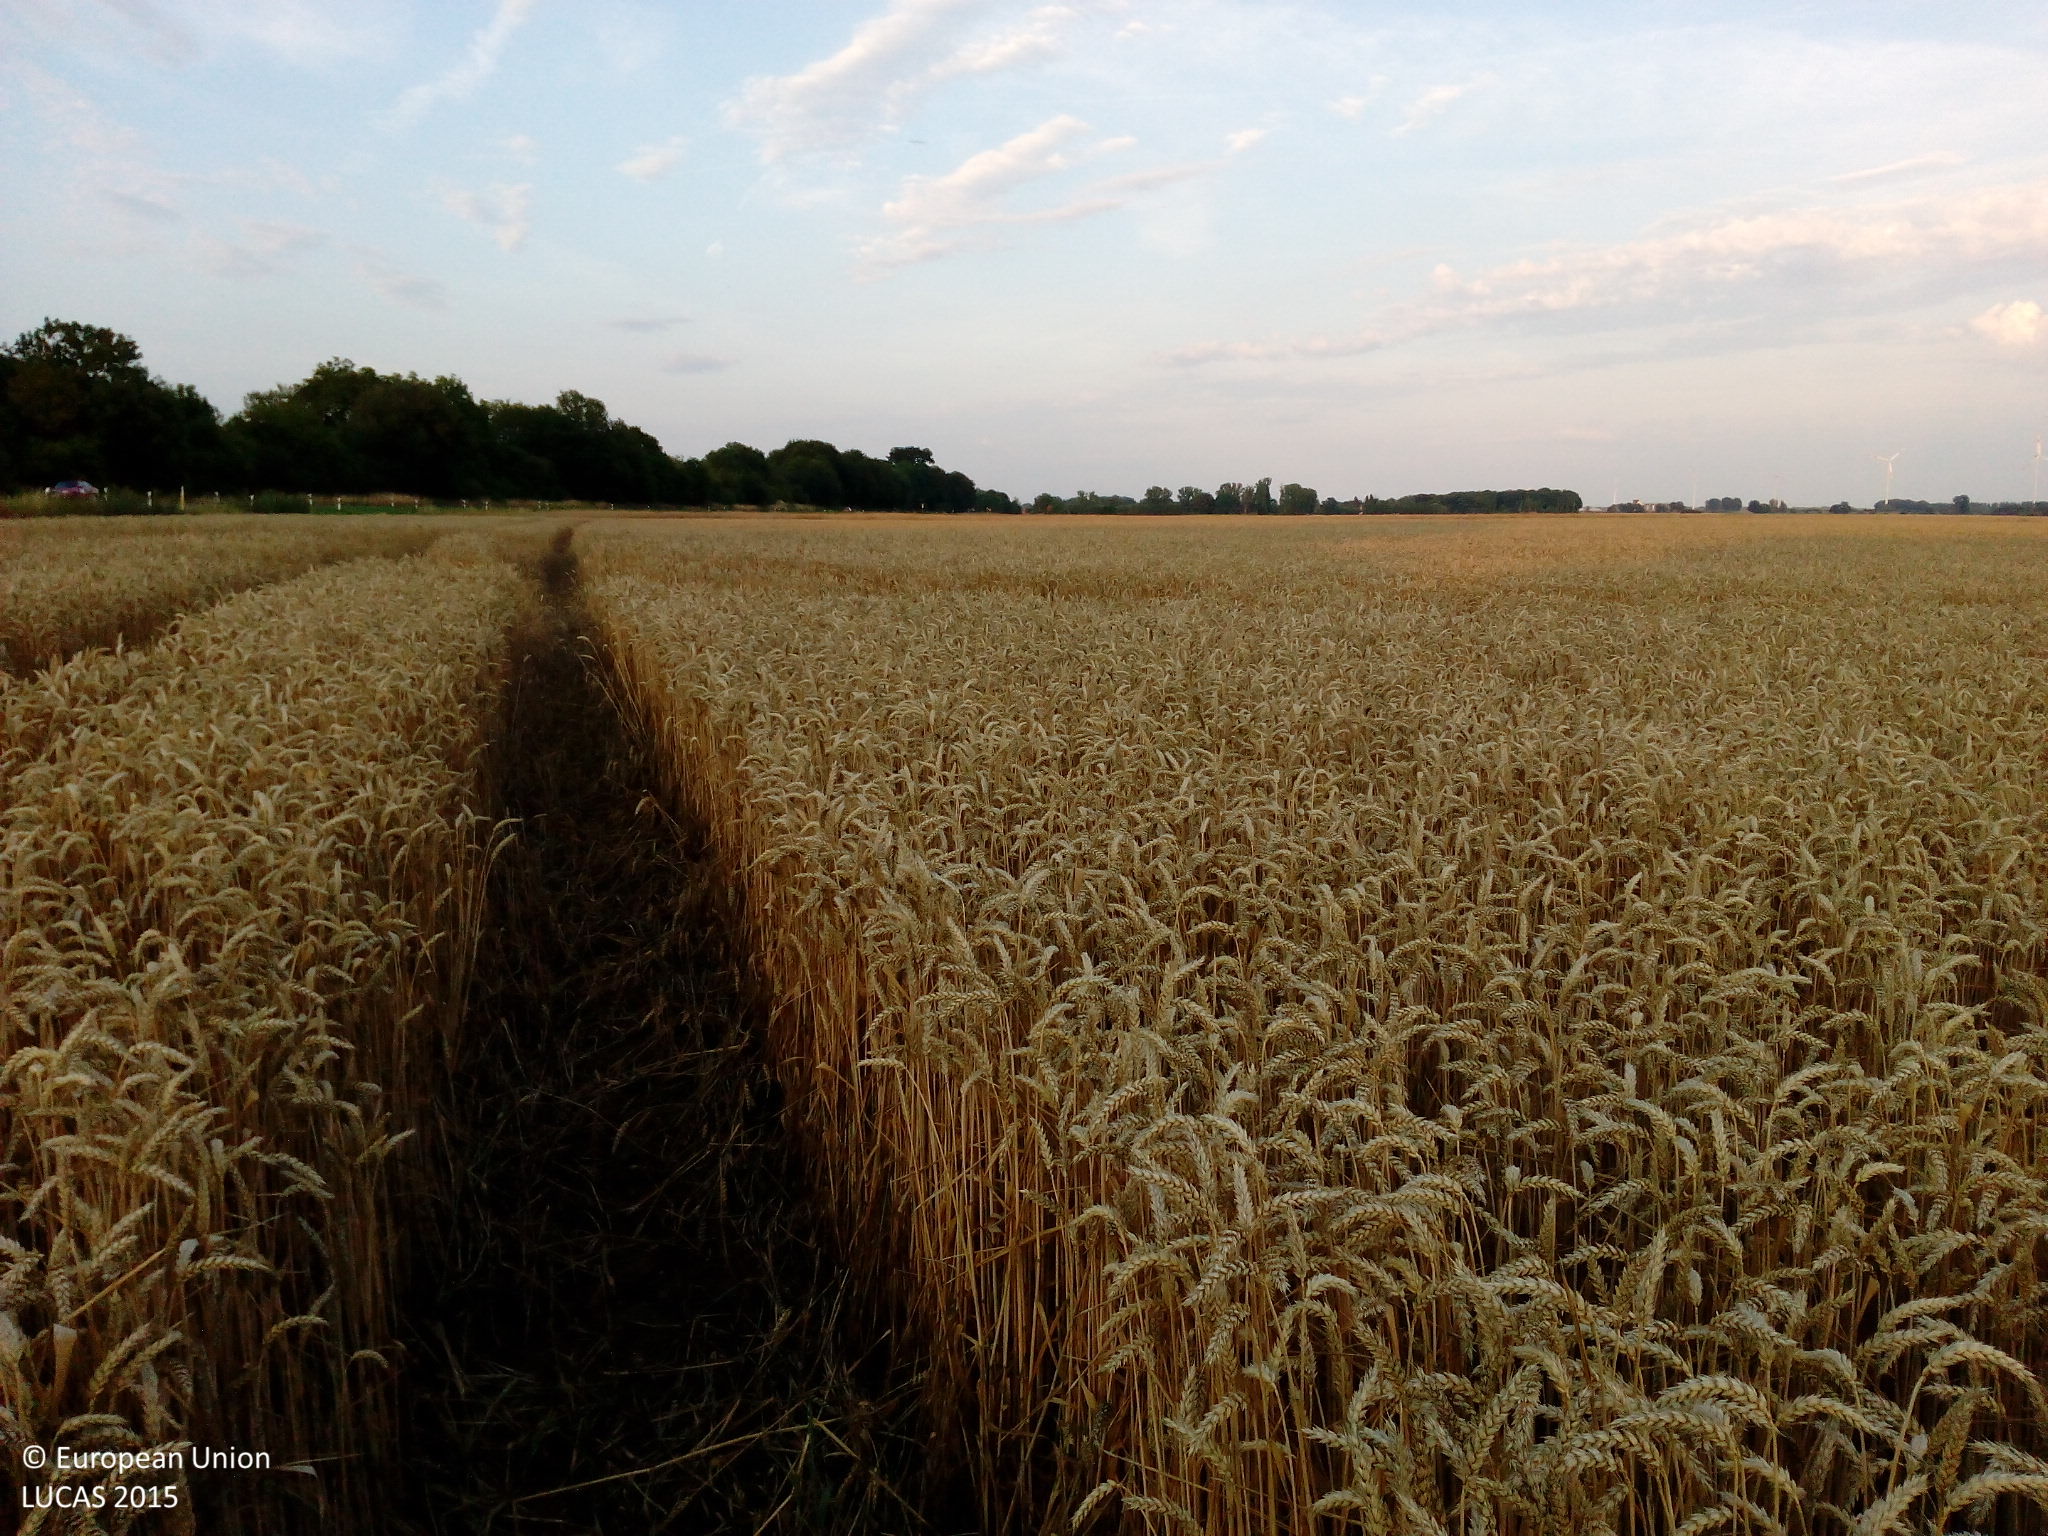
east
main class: Cropland
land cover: Common wheat
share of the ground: > 75 %
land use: Agriculture (excluding fallow land and kitchen gardens)
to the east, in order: Common wheat; Rape and turnip rape
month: July
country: DE
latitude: 52.7186
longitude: 14.1610
